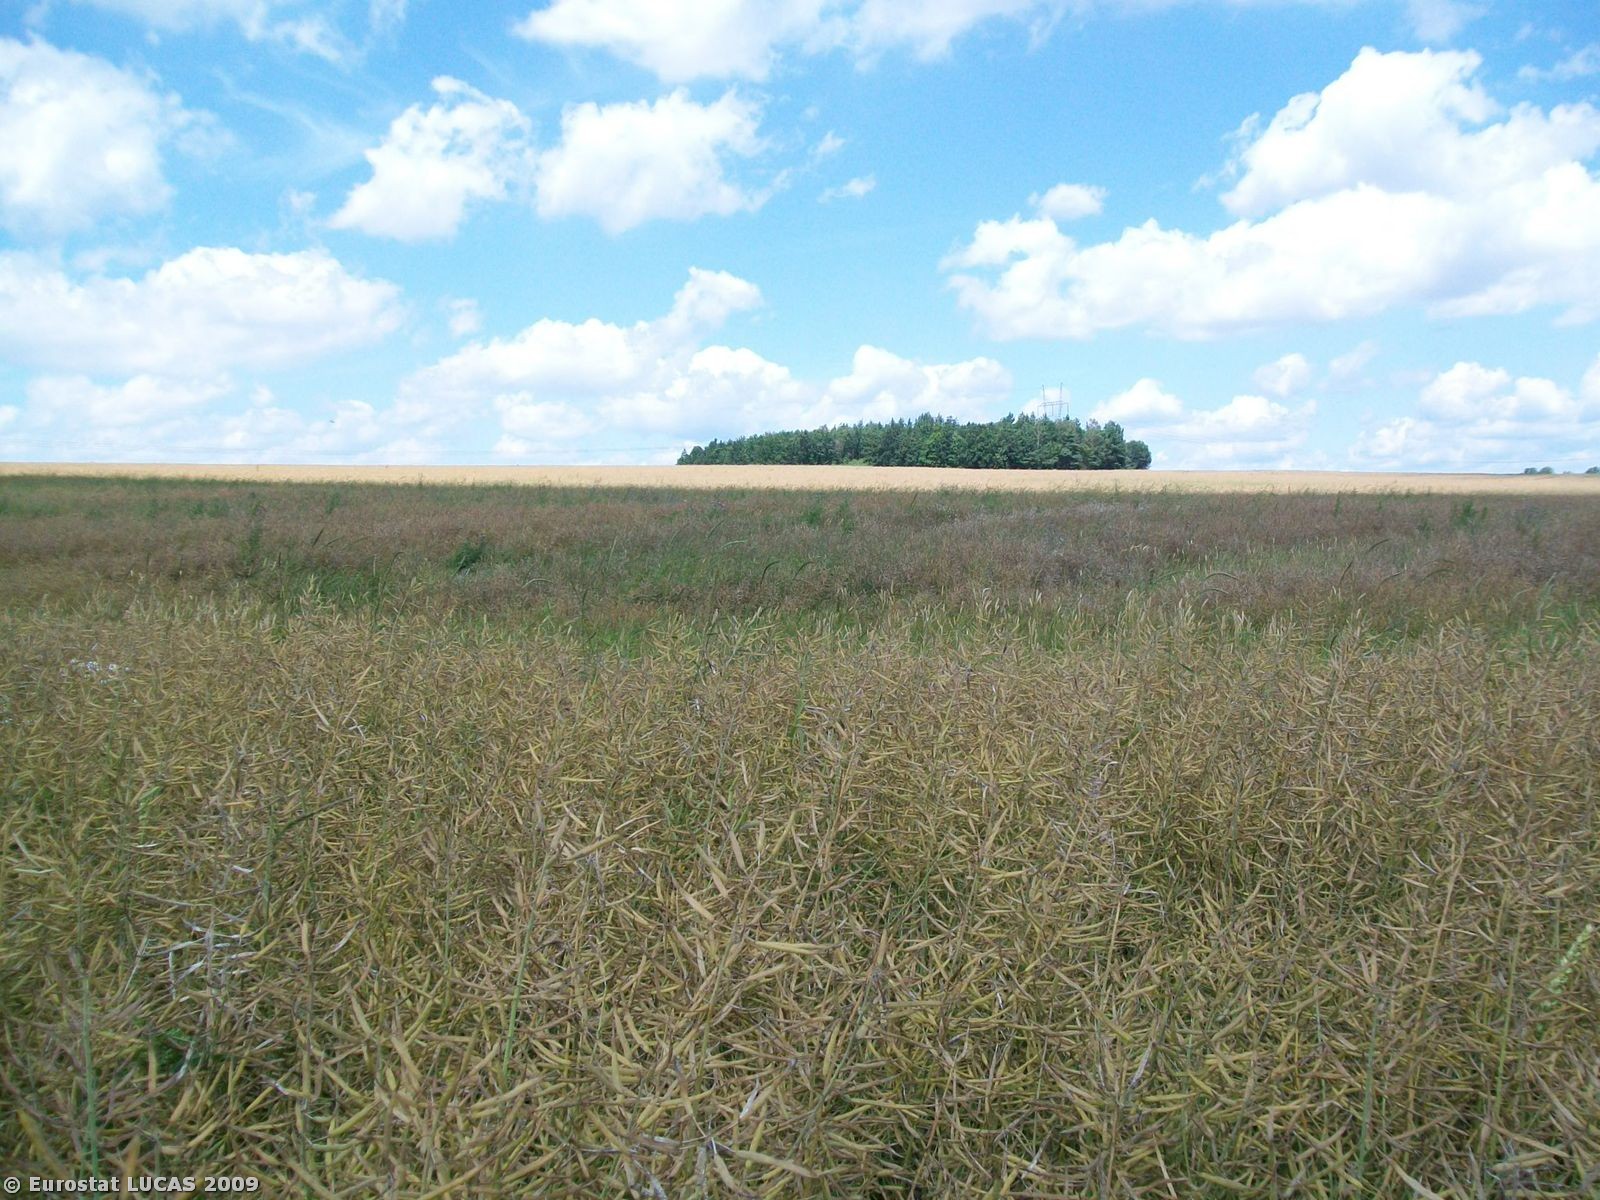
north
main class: Cropland
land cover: Rape and turnip rape
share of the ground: > 75 %
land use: Agriculture (excluding fallow land and kitchen gardens)
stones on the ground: < 10 %
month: July
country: PL
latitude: 51.1137
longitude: 15.1315
